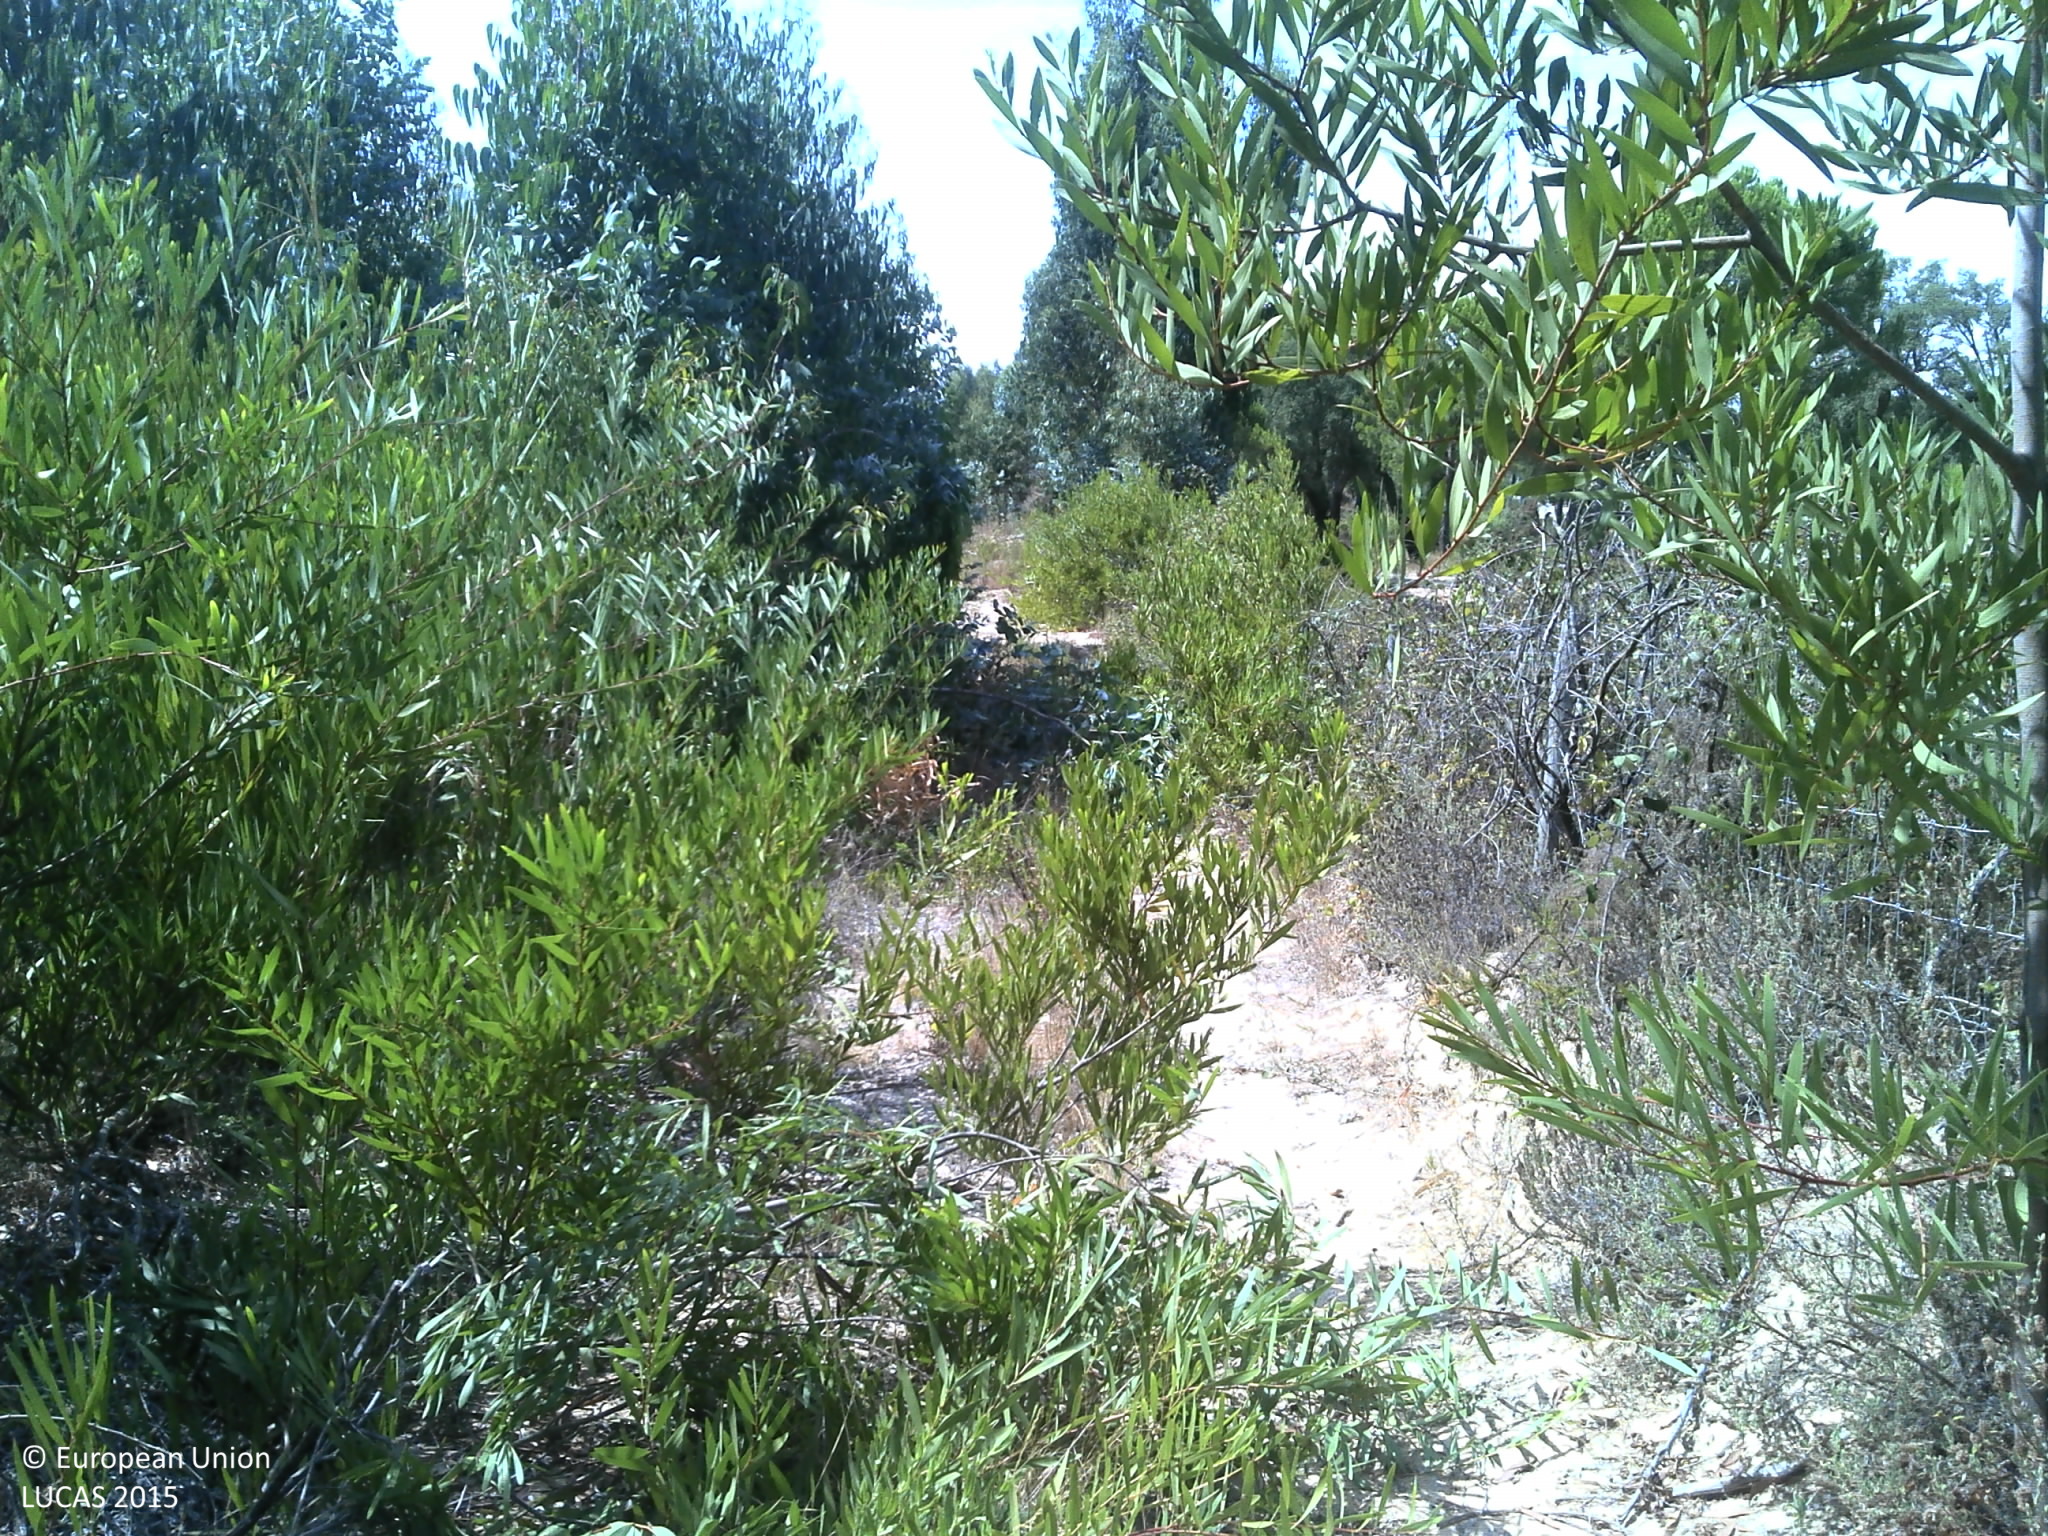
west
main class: Woodland
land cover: Pine dominated mixed woodland
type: coniferous forest of the mediterranean region
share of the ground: 25 - 50 %
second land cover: Shrubland without tree cover
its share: 10 - 25 %
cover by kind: unconsolidated bare surface 35 %, coniferous forest trees 30 %, broadleaved forest trees 20 %, shrubs 15 %
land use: Forestry
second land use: Agriculture (excluding fallow land and kitchen gardens)
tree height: > 5 m
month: August
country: PT
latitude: 38.7316
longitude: -8.5920
